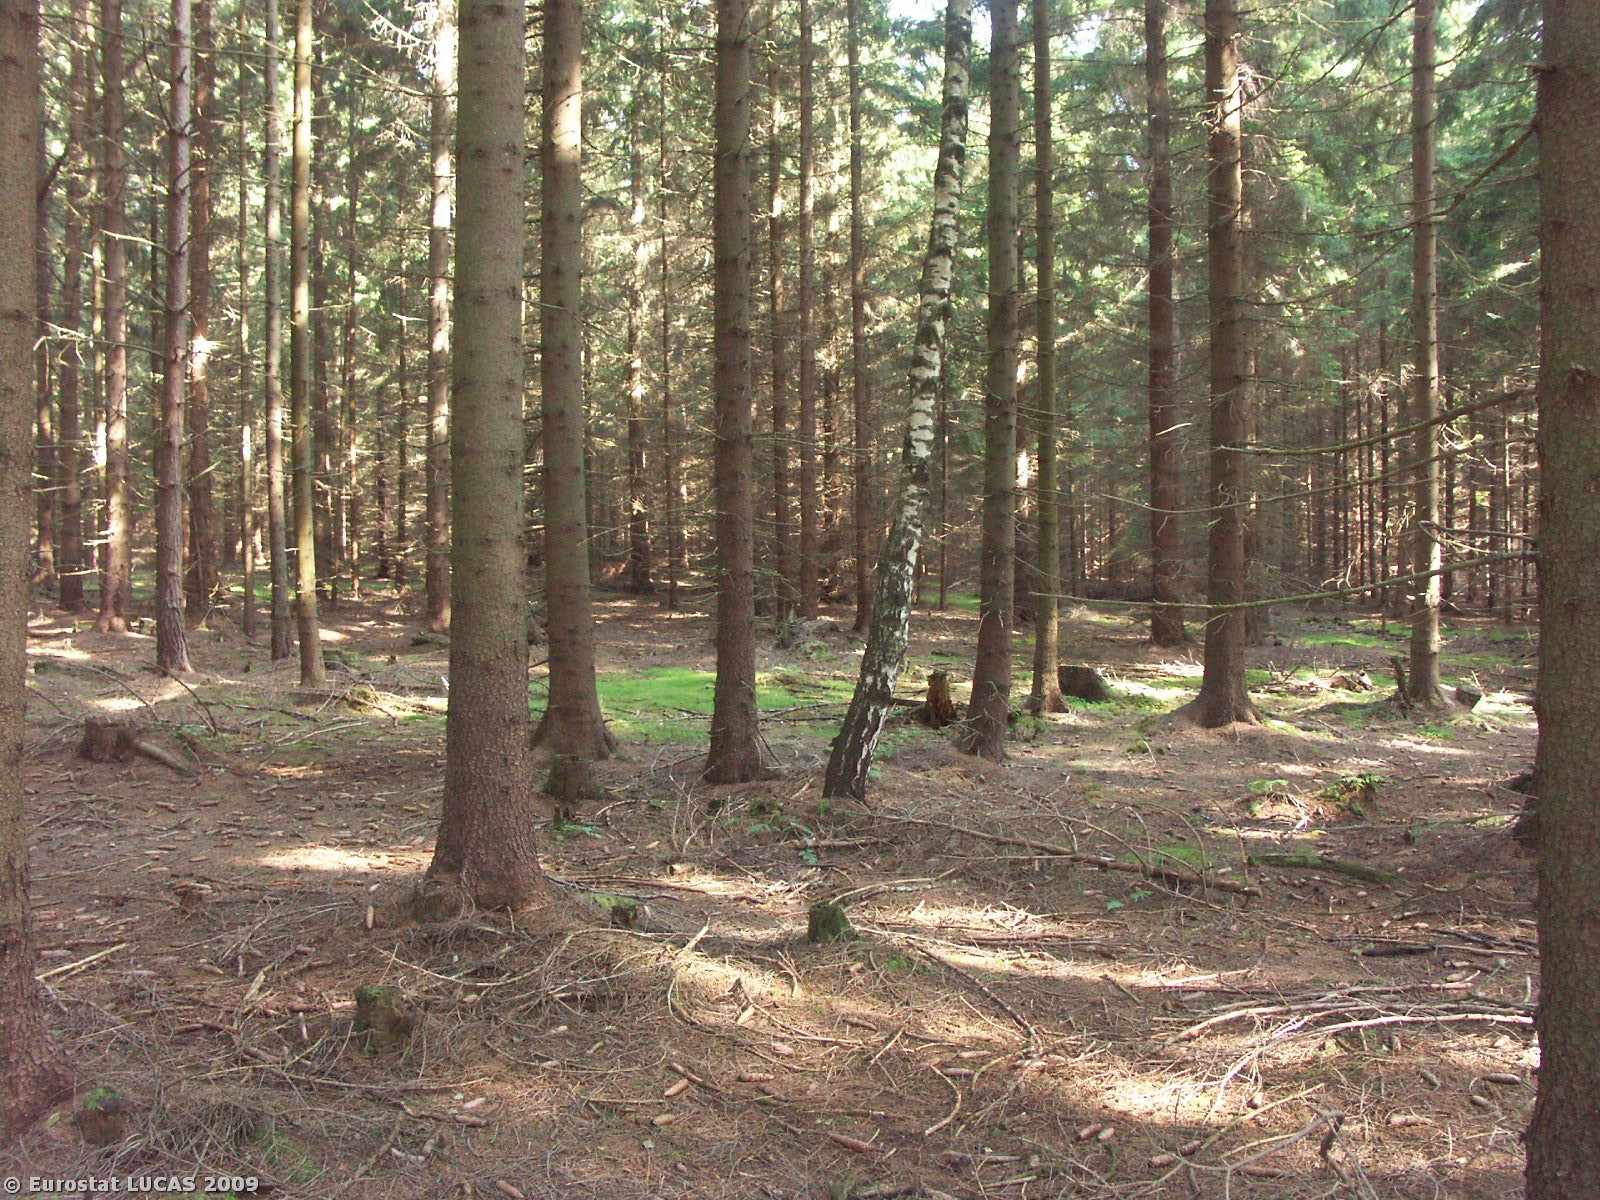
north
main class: Woodland
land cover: Coniferous woodland
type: hemiboreal forest and nemoral coniferous forest and mixed broadleaved-coniferous forest
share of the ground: > 75 %
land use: Forestry
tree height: > 5 m
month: July
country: CZ
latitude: 49.9787
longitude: 17.4167
